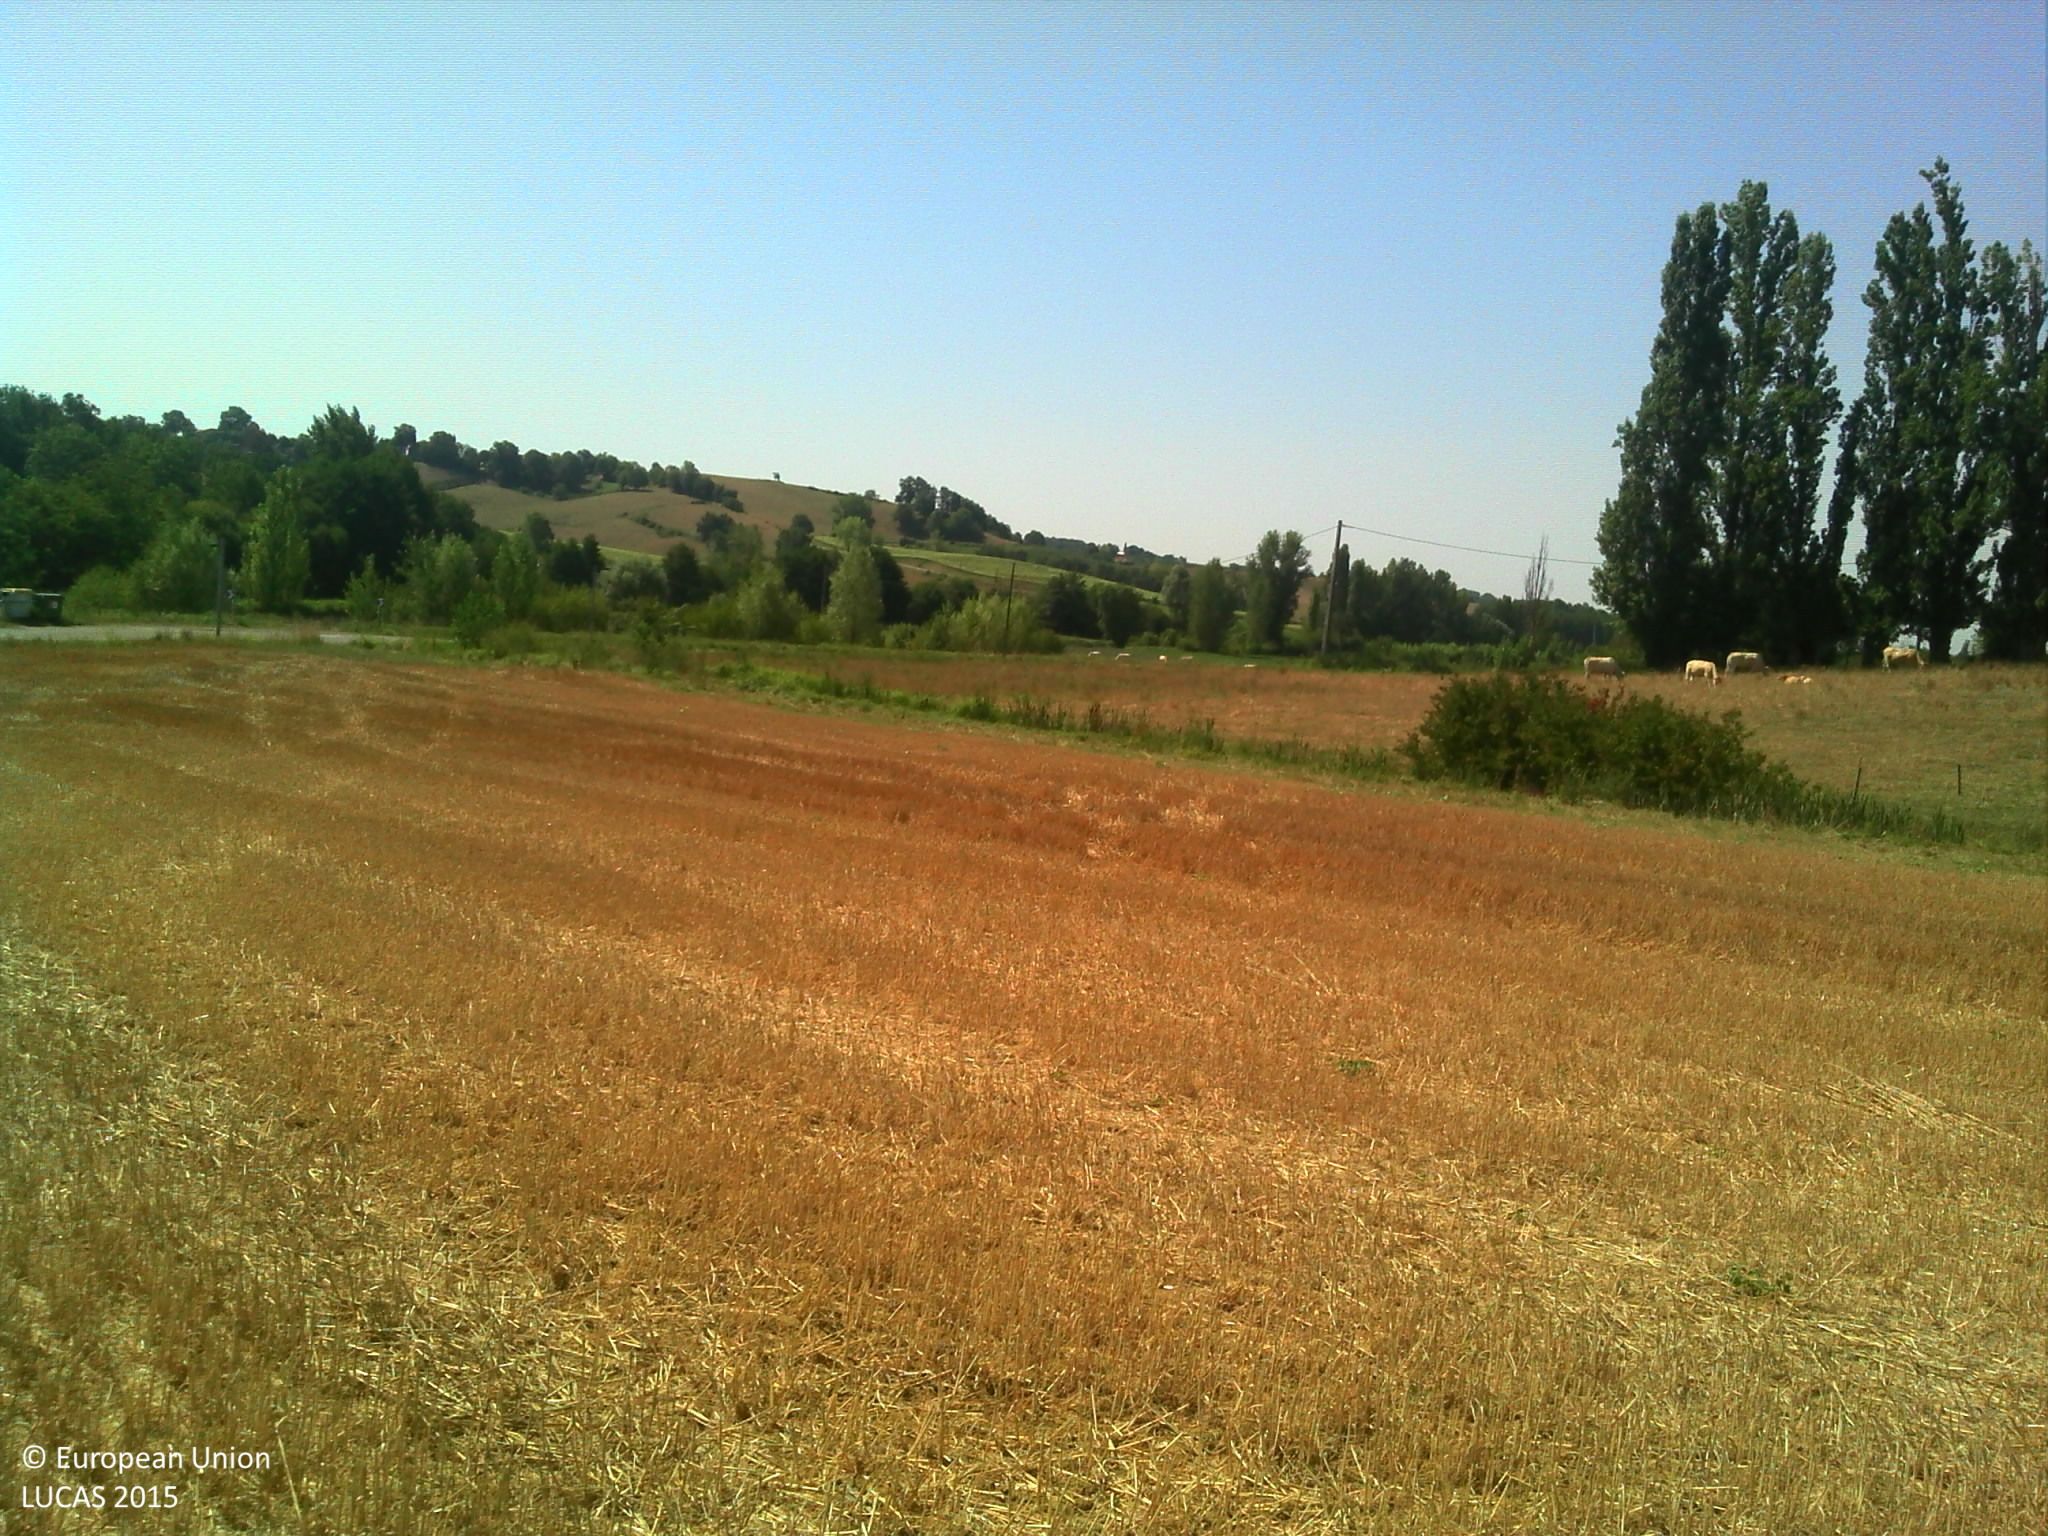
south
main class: Cropland
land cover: Common wheat
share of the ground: > 75 %
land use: Agriculture (excluding fallow land and kitchen gardens)
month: August
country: FR
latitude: 44.1960
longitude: 1.2273
